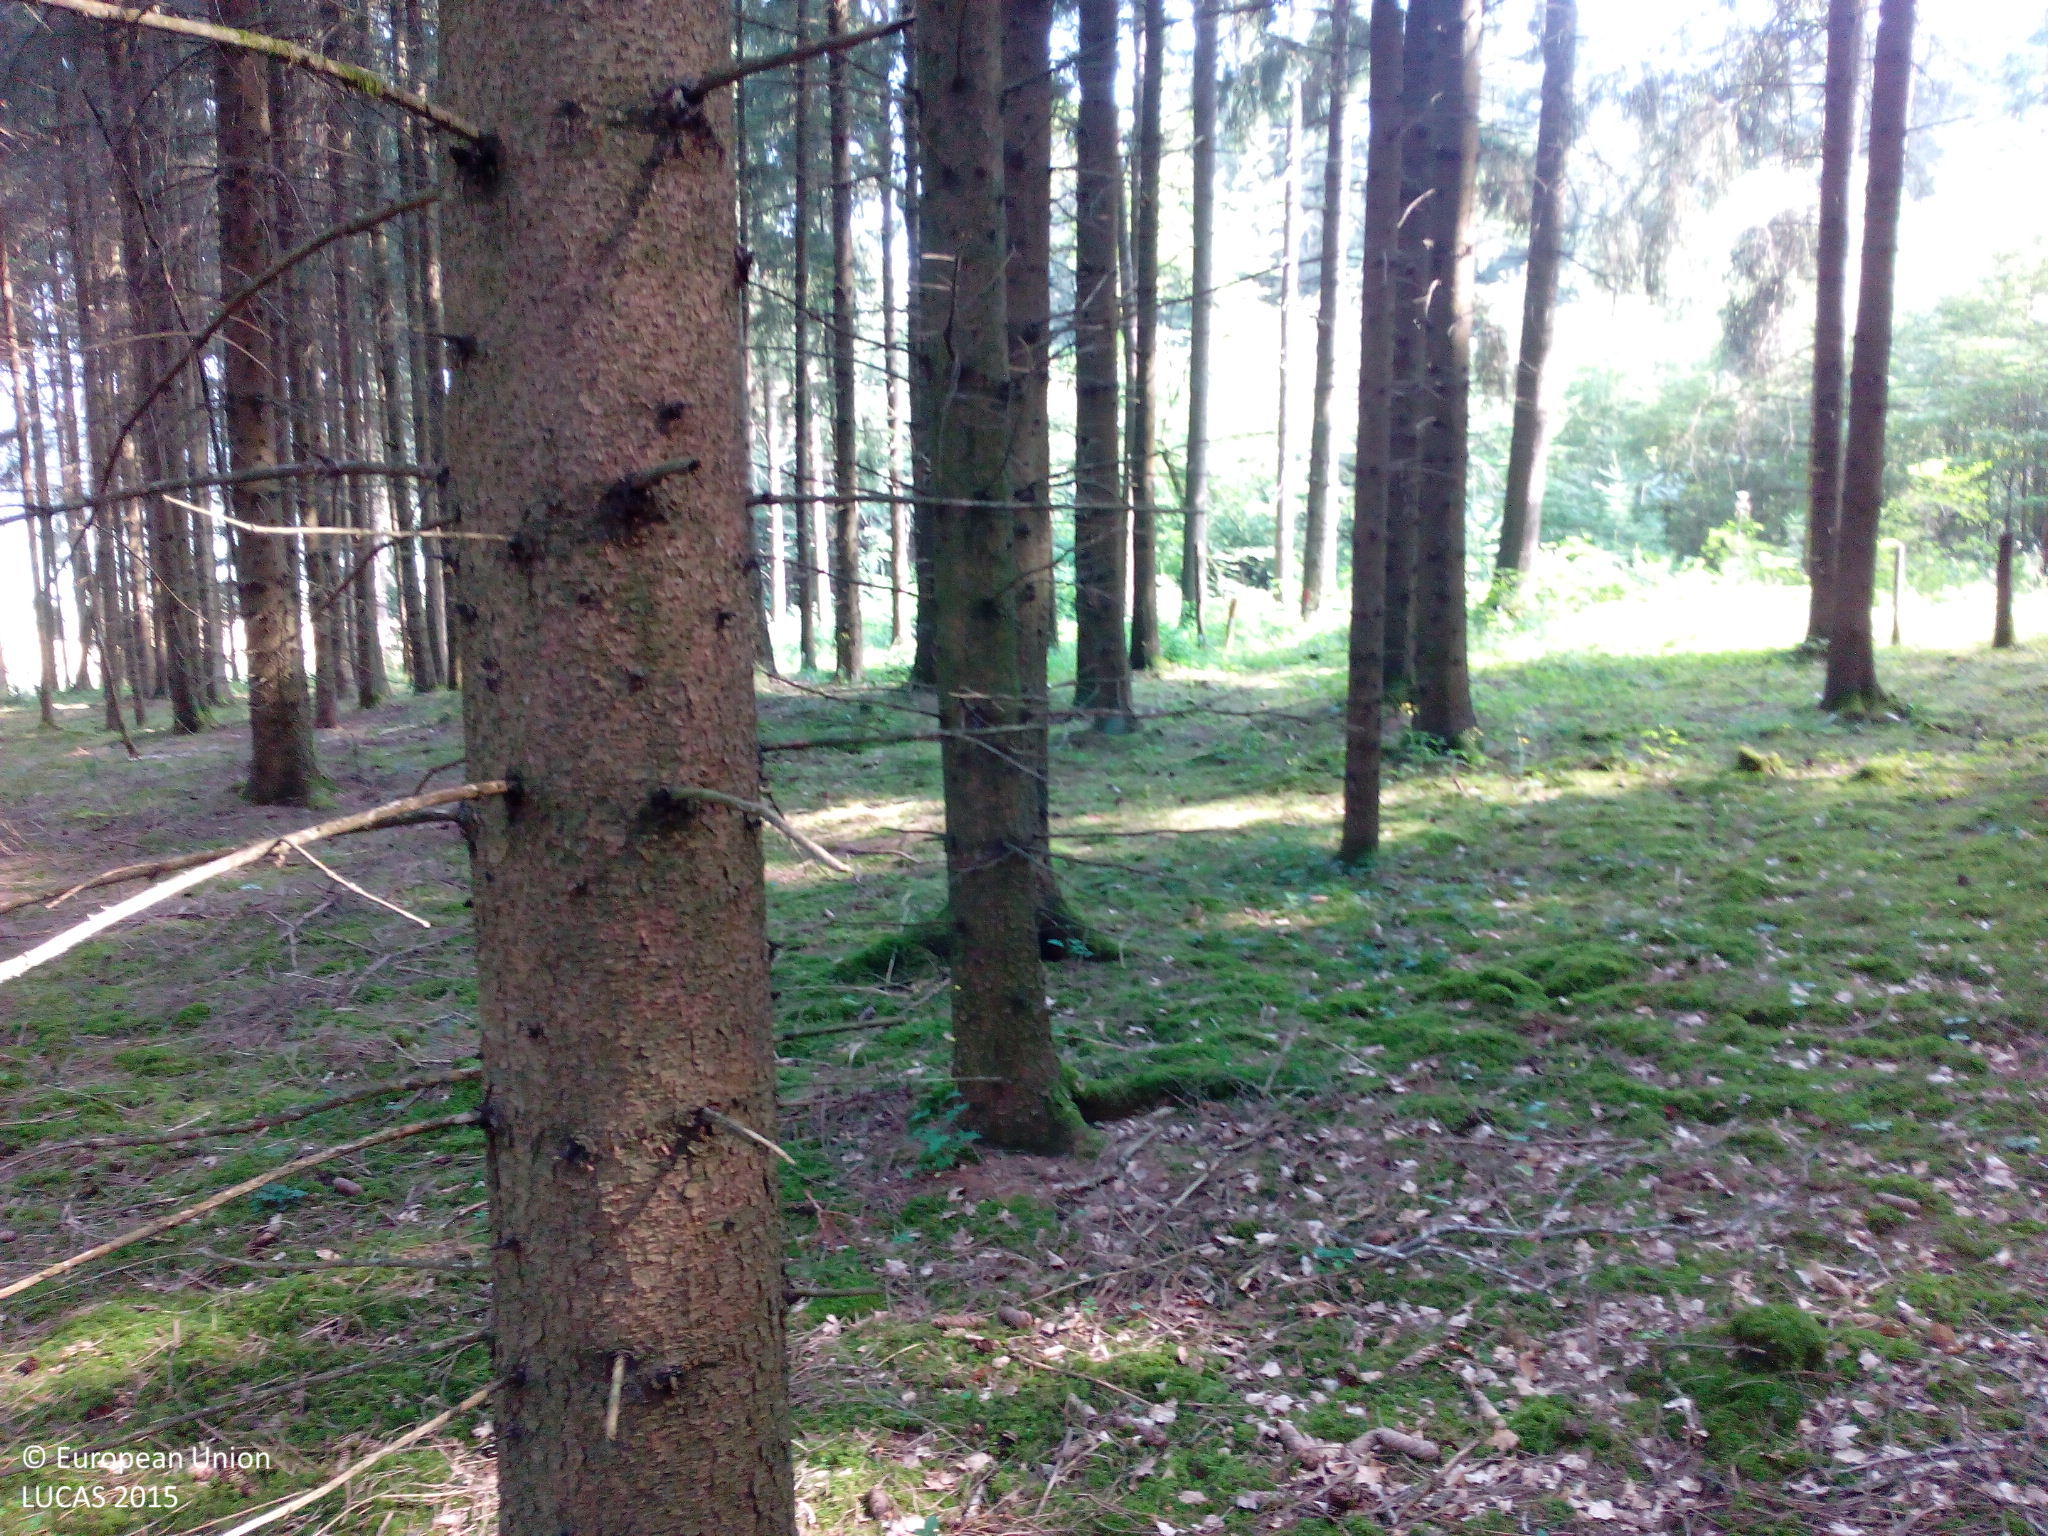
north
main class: Woodland
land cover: Spruce dominated coniferous woodland
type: hemiboreal forest and nemoral coniferous forest and mixed broadleaved-coniferous forest
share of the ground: > 75 %
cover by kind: coniferous forest trees 95 %, broadleaved forest trees 5 %
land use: Forestry
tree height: > 5 m
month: July
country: DE
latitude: 48.1854
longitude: 9.3144
